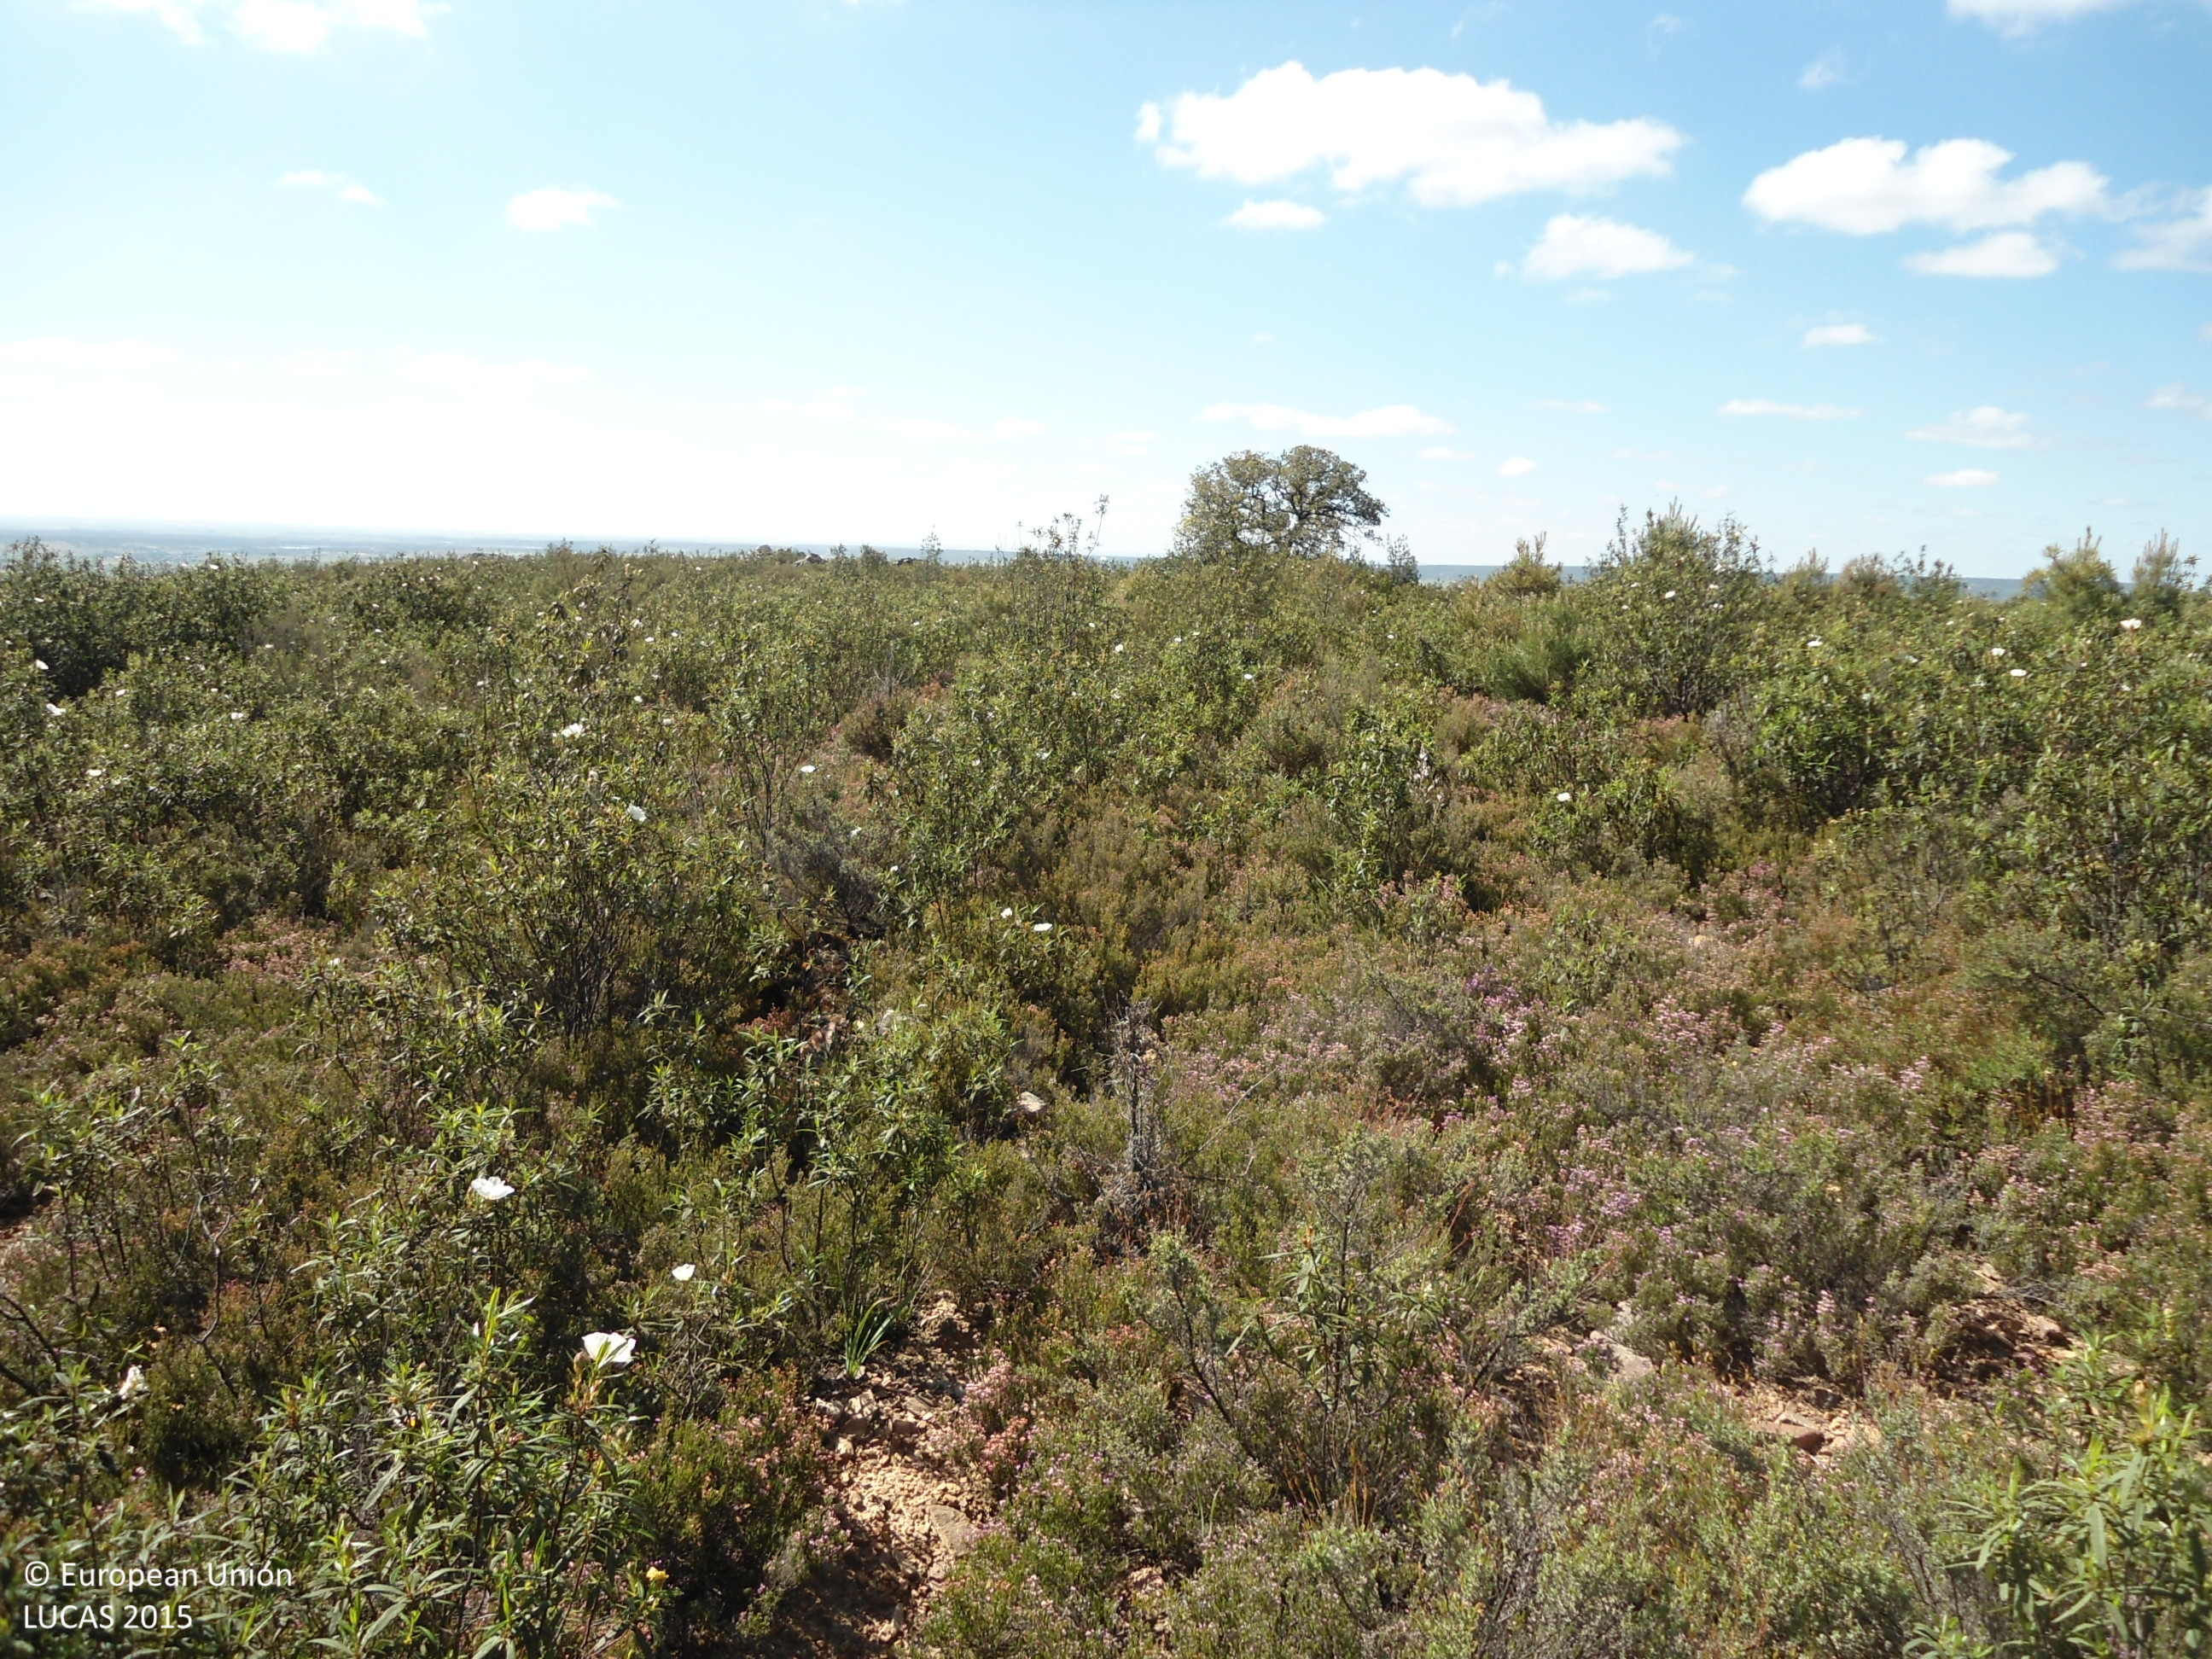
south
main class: Shrubland
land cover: Shrubland without tree cover
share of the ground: > 75 %
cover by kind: shrubs 100 %
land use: Semi-natural and natural areas not in use
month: May
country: ES
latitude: 41.8643
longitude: -5.9129
